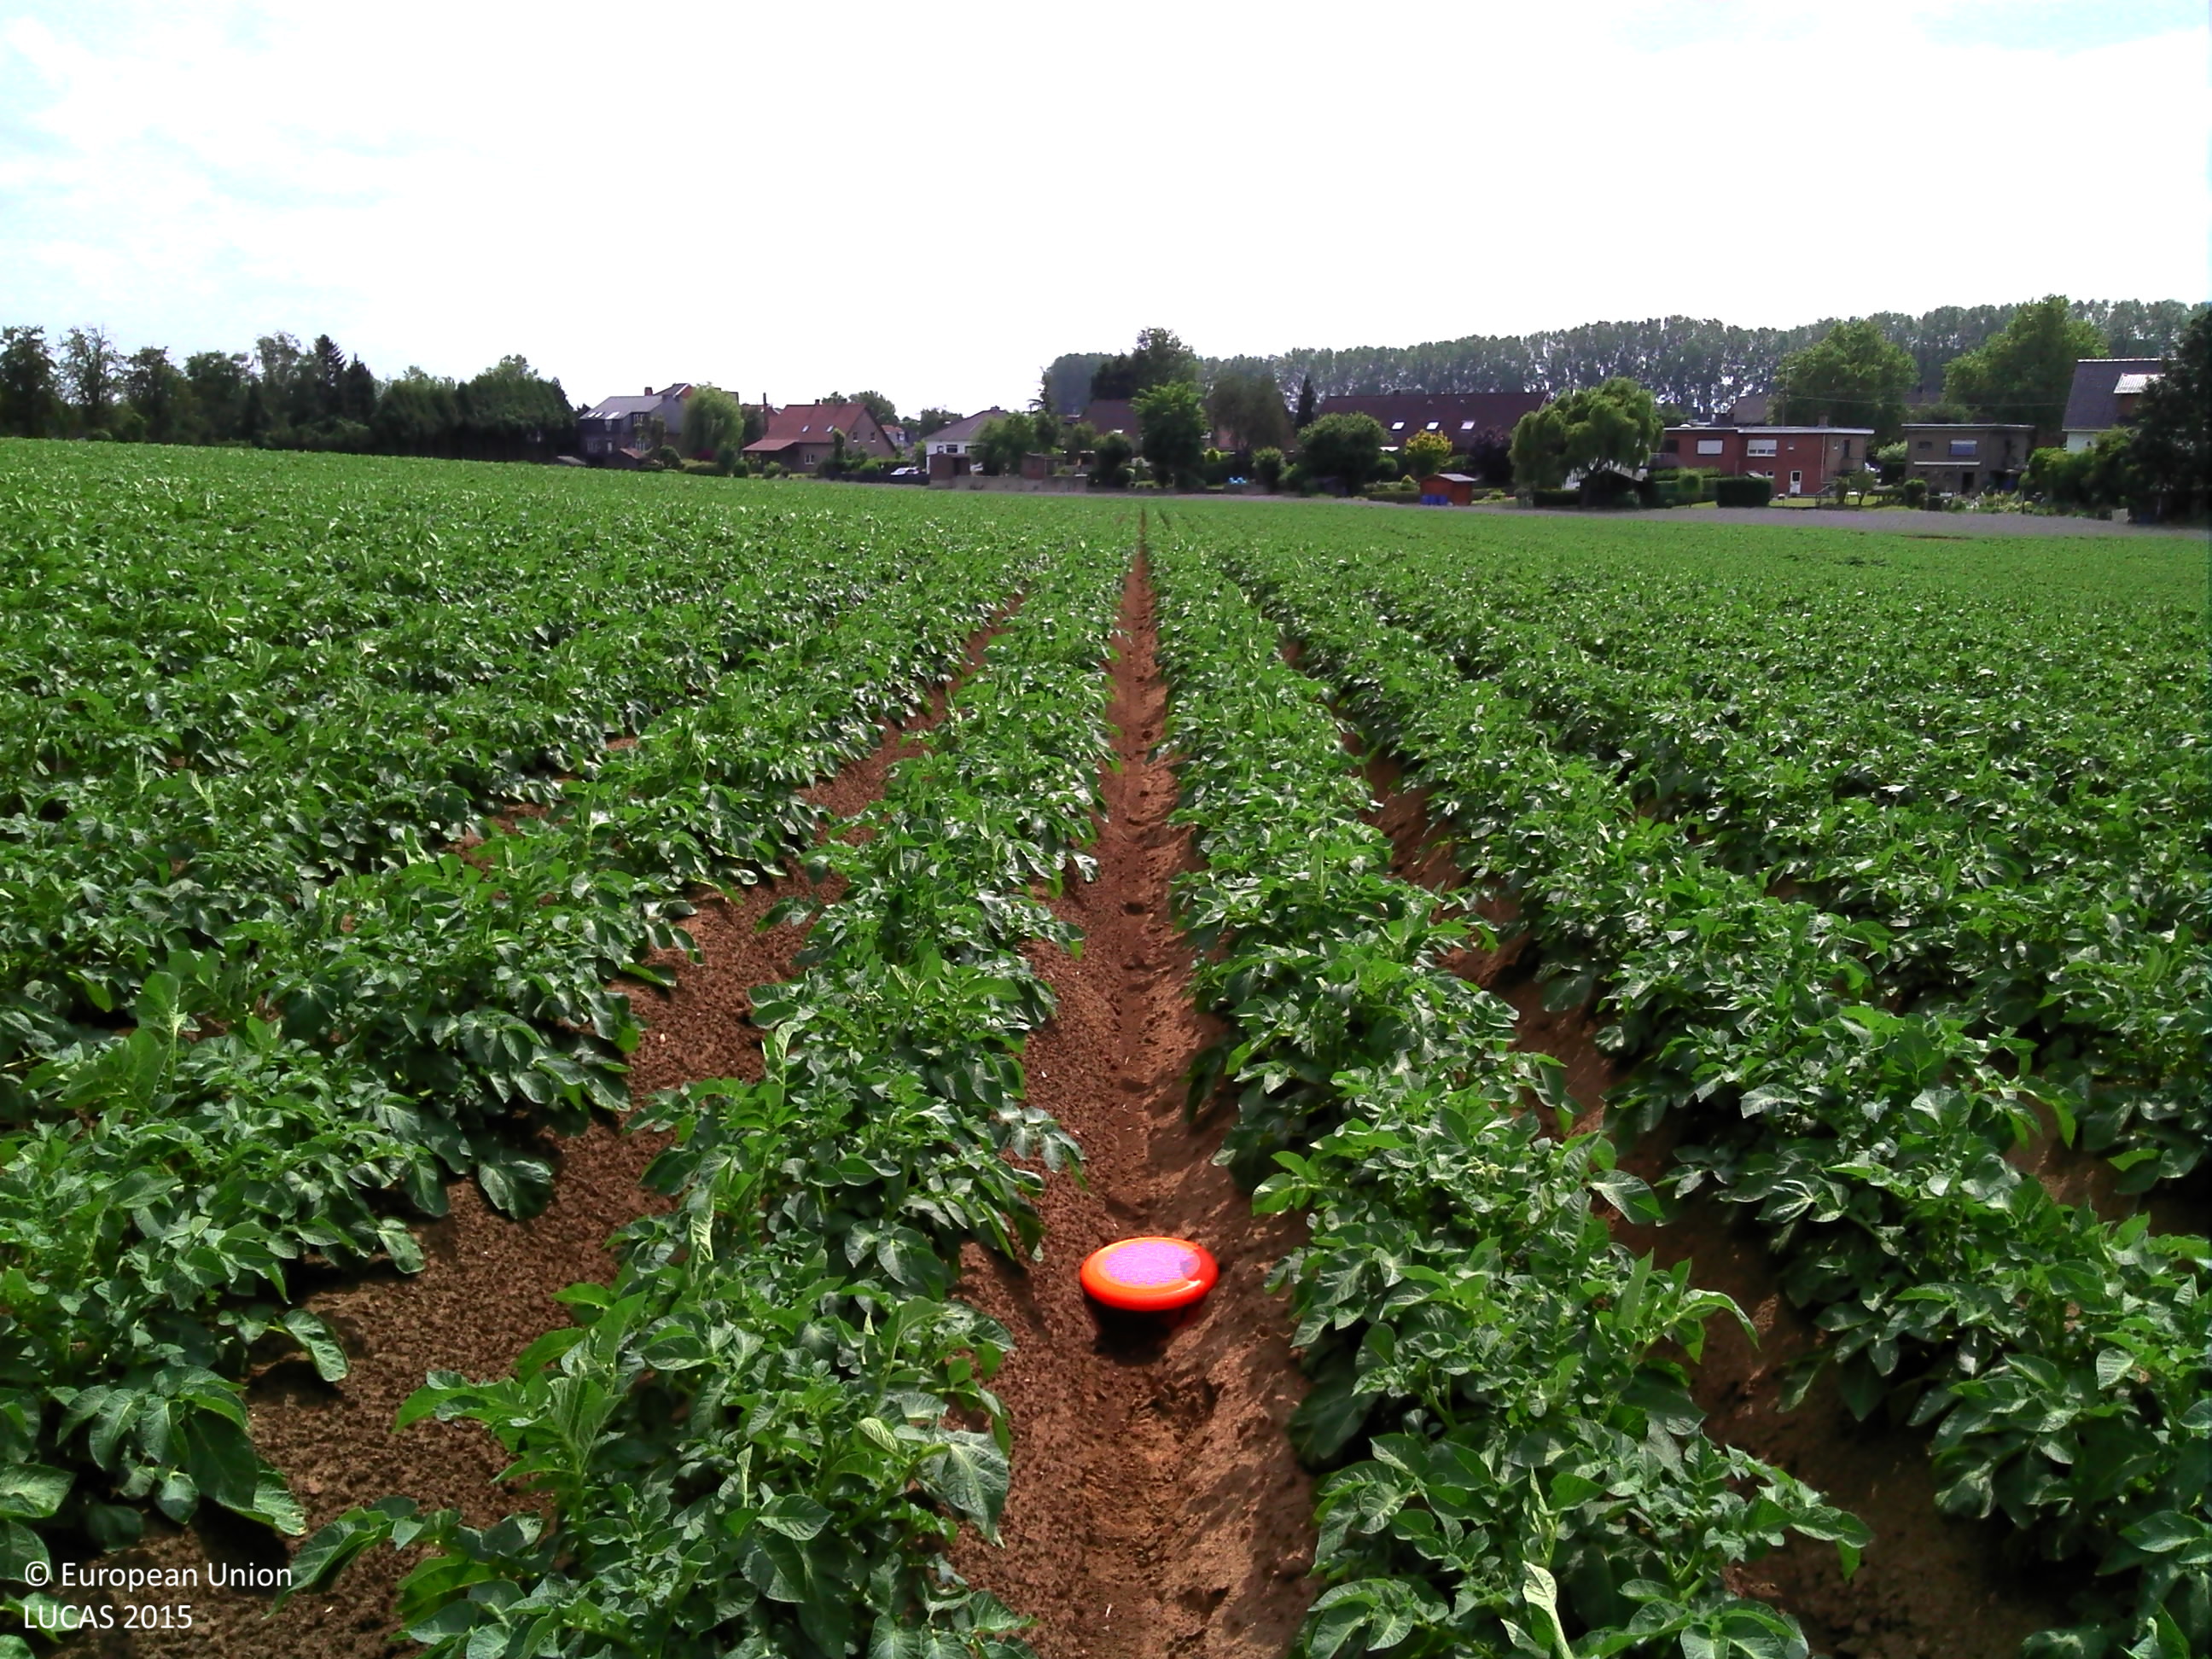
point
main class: Cropland
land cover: Potatoes
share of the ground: 50 - 75 %
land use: Agriculture (excluding fallow land and kitchen gardens)
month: June
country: BE
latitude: 50.6913
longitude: 5.5392
